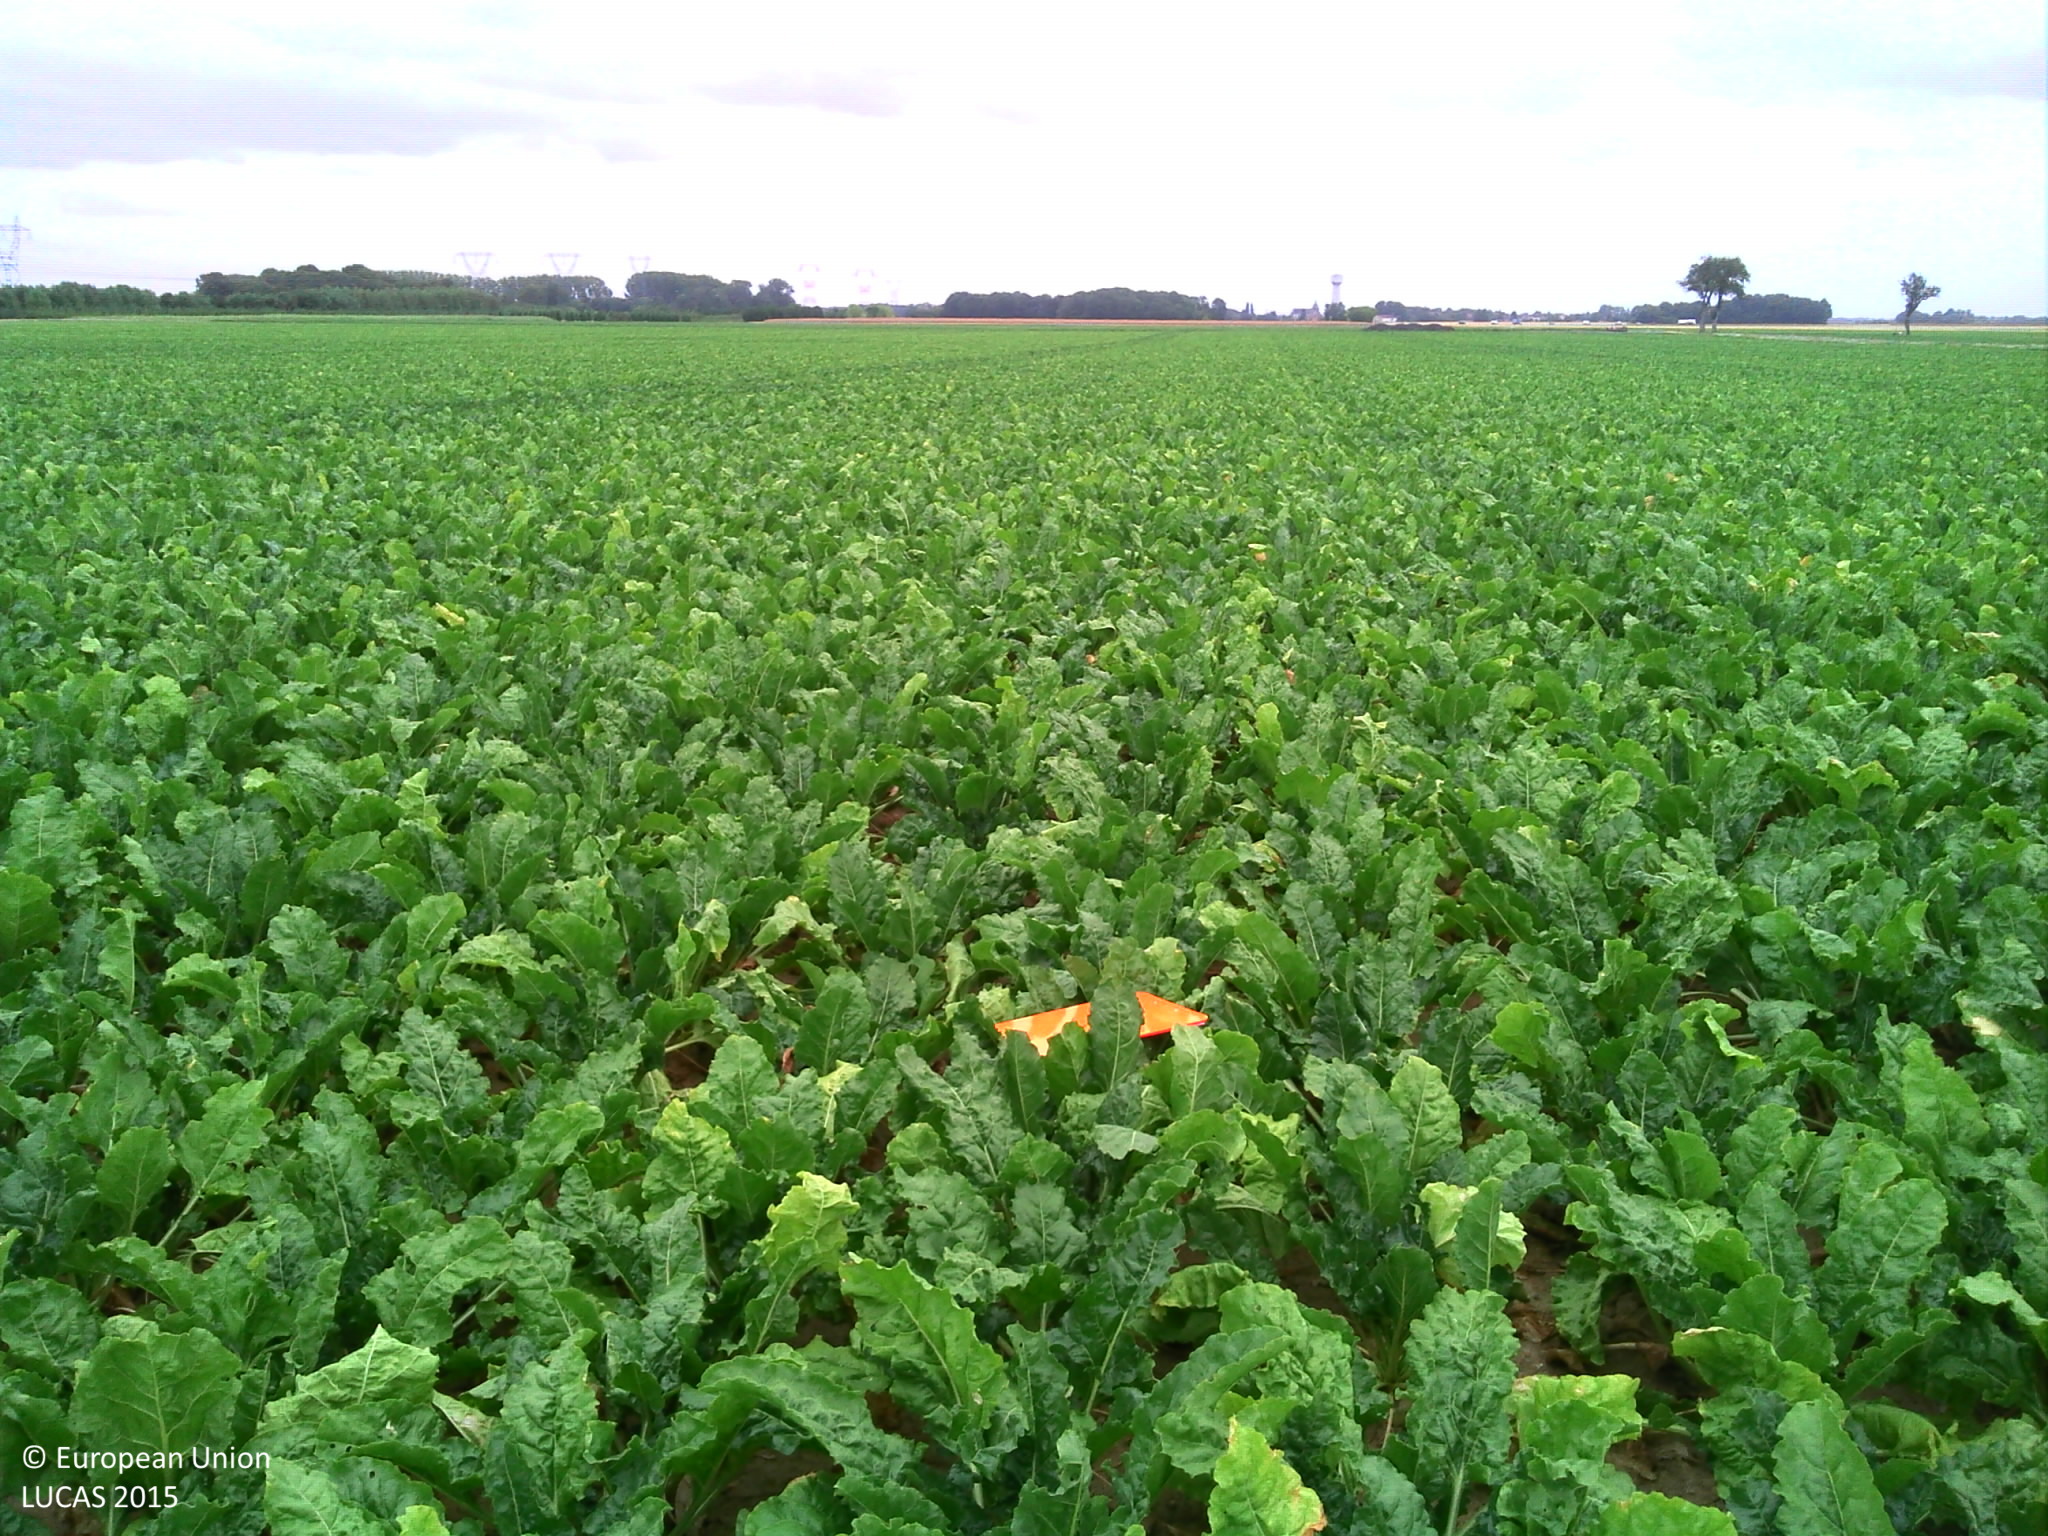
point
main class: Cropland
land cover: Sugar beet
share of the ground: > 75 %
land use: Agriculture (excluding fallow land and kitchen gardens)
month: July
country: FR
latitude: 48.6159
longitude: 2.7333
